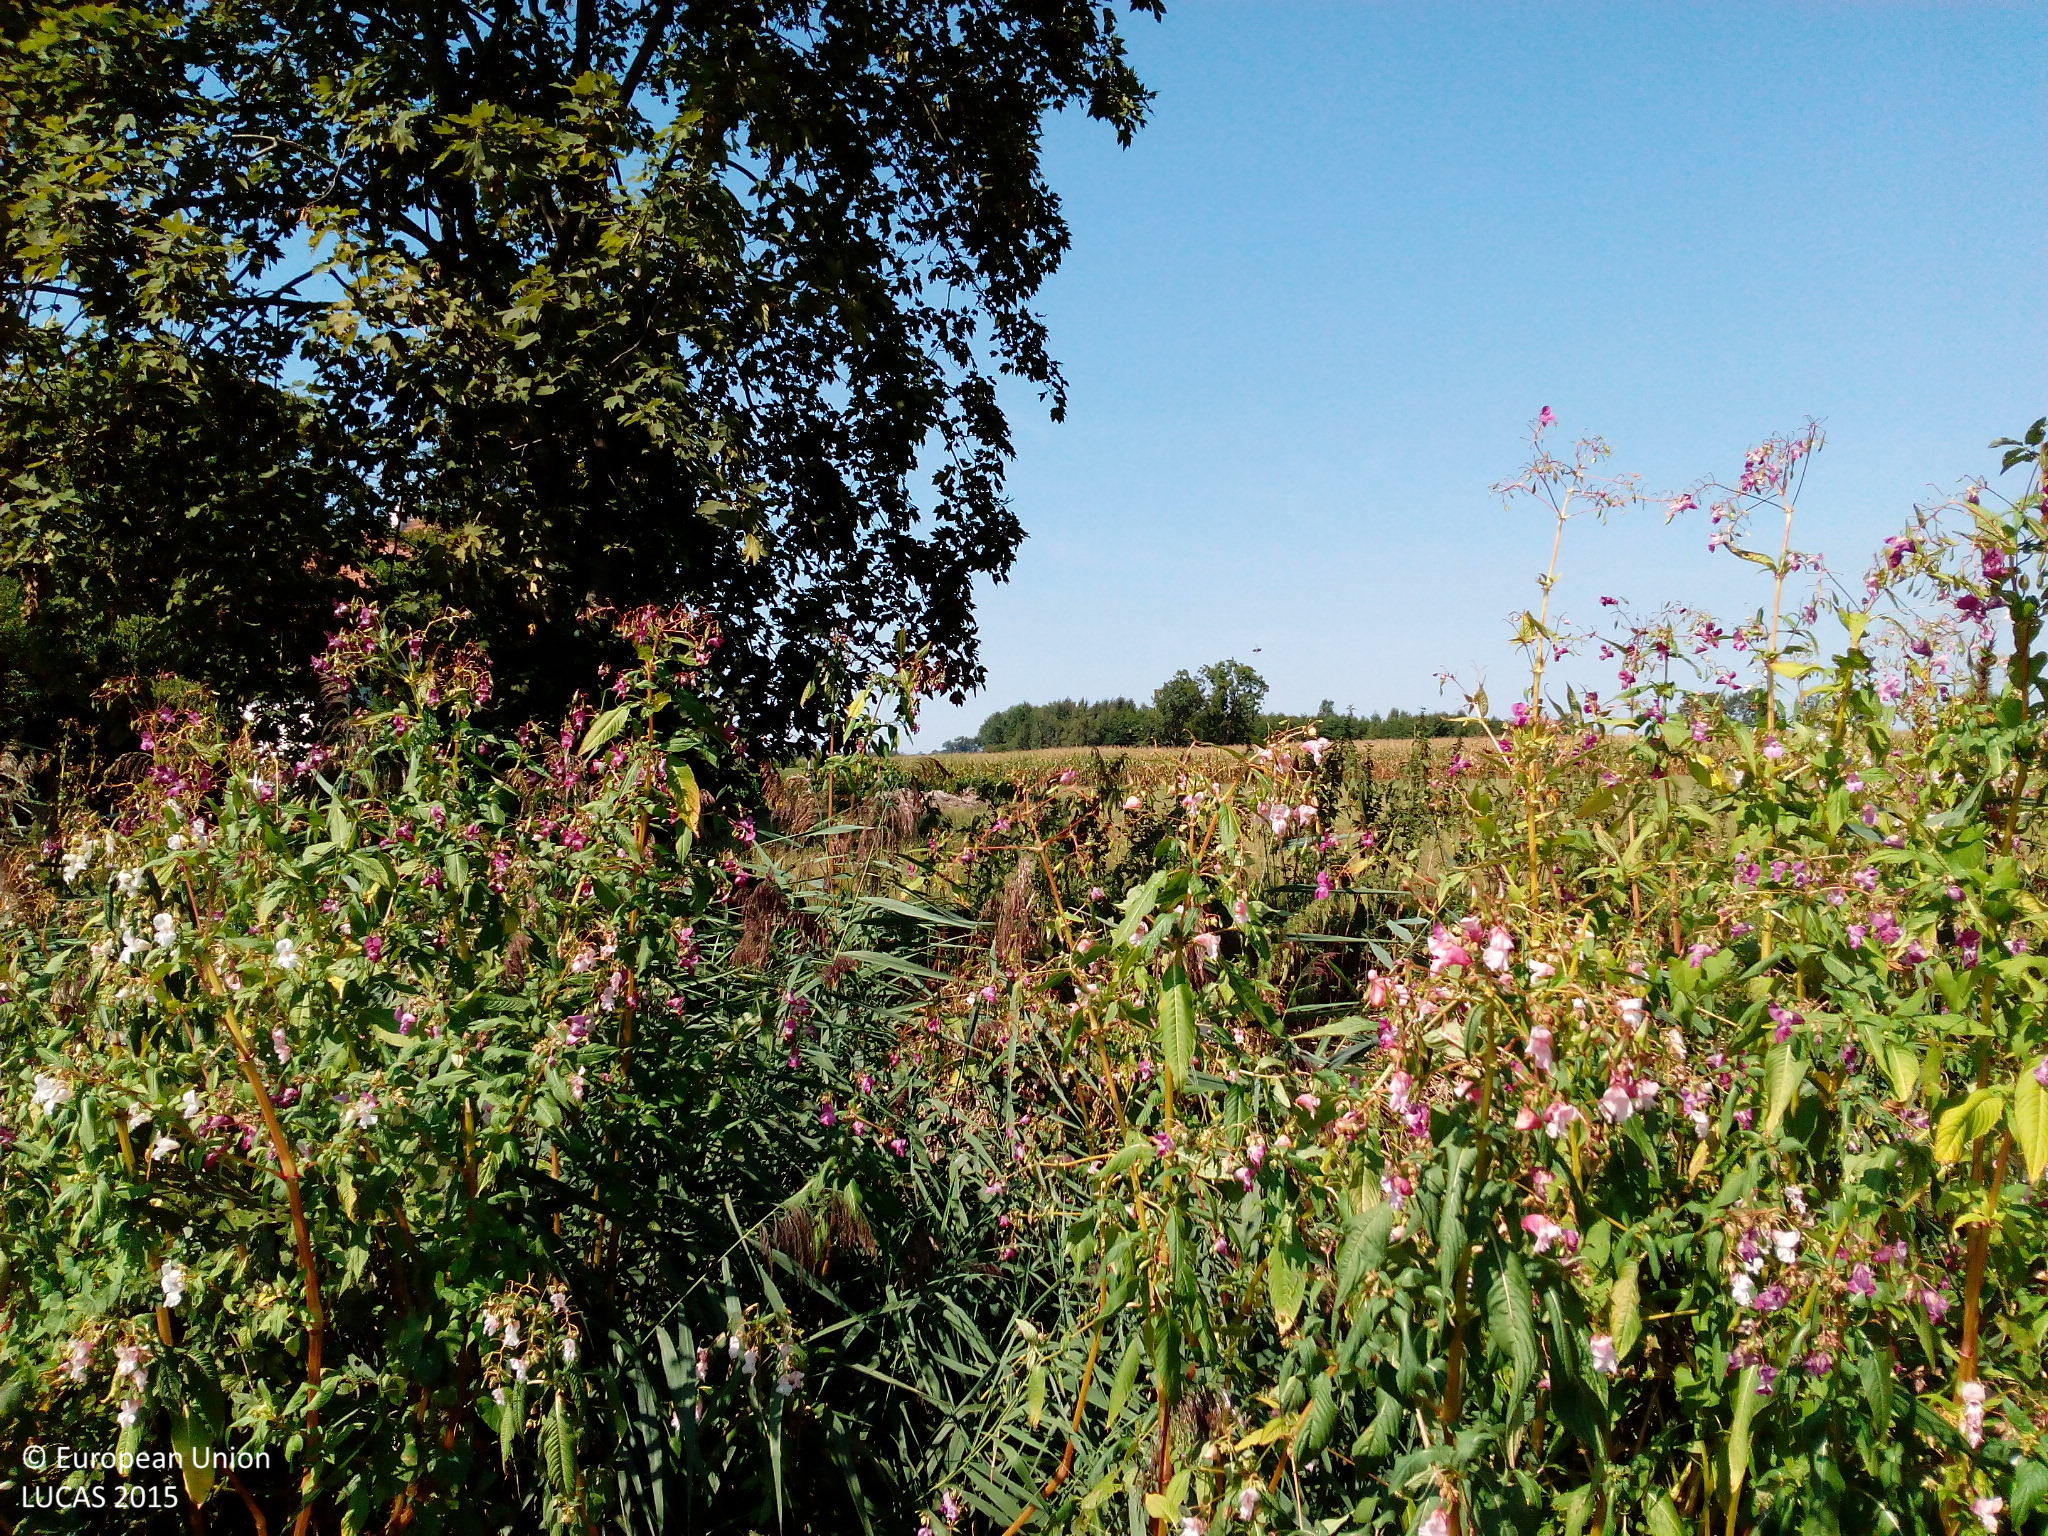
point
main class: Grassland
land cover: Grassland without tree/shrub cover
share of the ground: > 75 %
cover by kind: herbaceous plants 95 %, unconsolidated bare surface 5 %
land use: Agriculture (excluding fallow land and kitchen gardens)
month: August
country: DE
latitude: 48.4931
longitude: 10.2570
